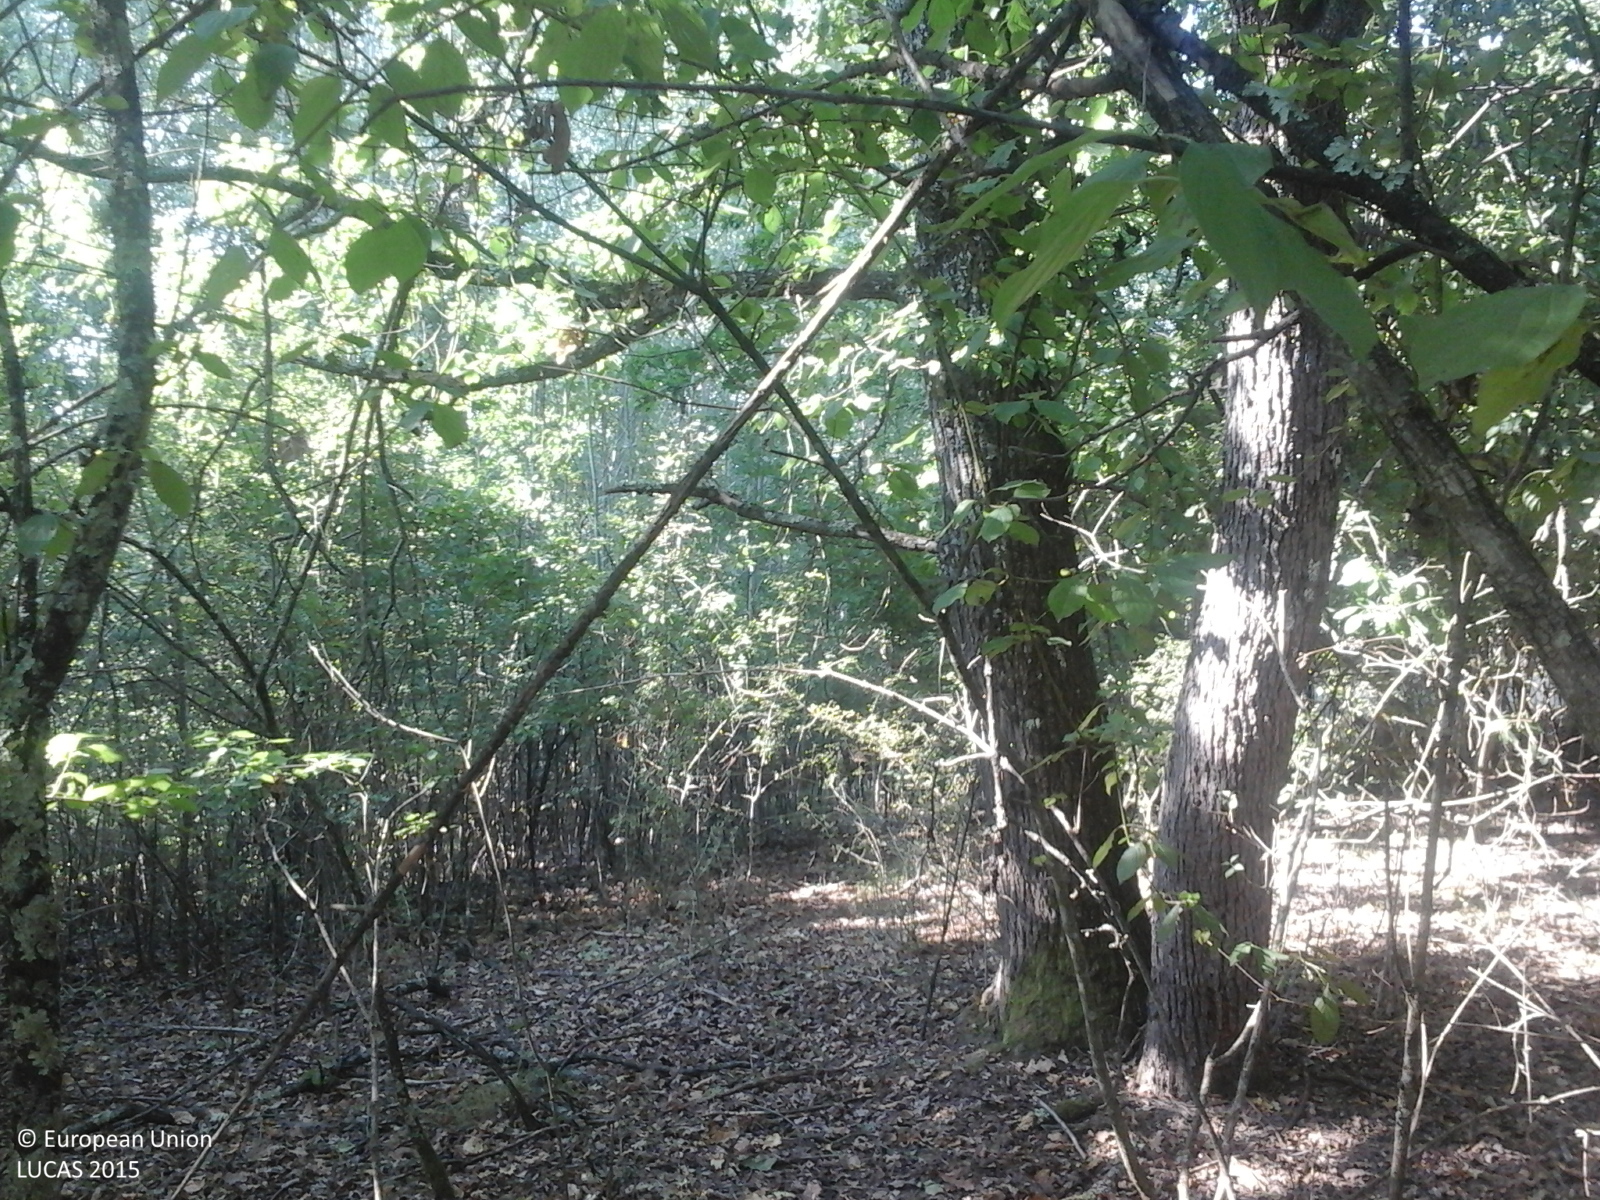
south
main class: Woodland
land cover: Broadleaved woodland
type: acidophilous oak and oak-birch forest
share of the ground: > 75 %
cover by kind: broadleaved forest trees 100 %
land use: Forestry
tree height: > 5 m
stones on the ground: < 10 %
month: August
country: RO
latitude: 46.4133
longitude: 22.2108
